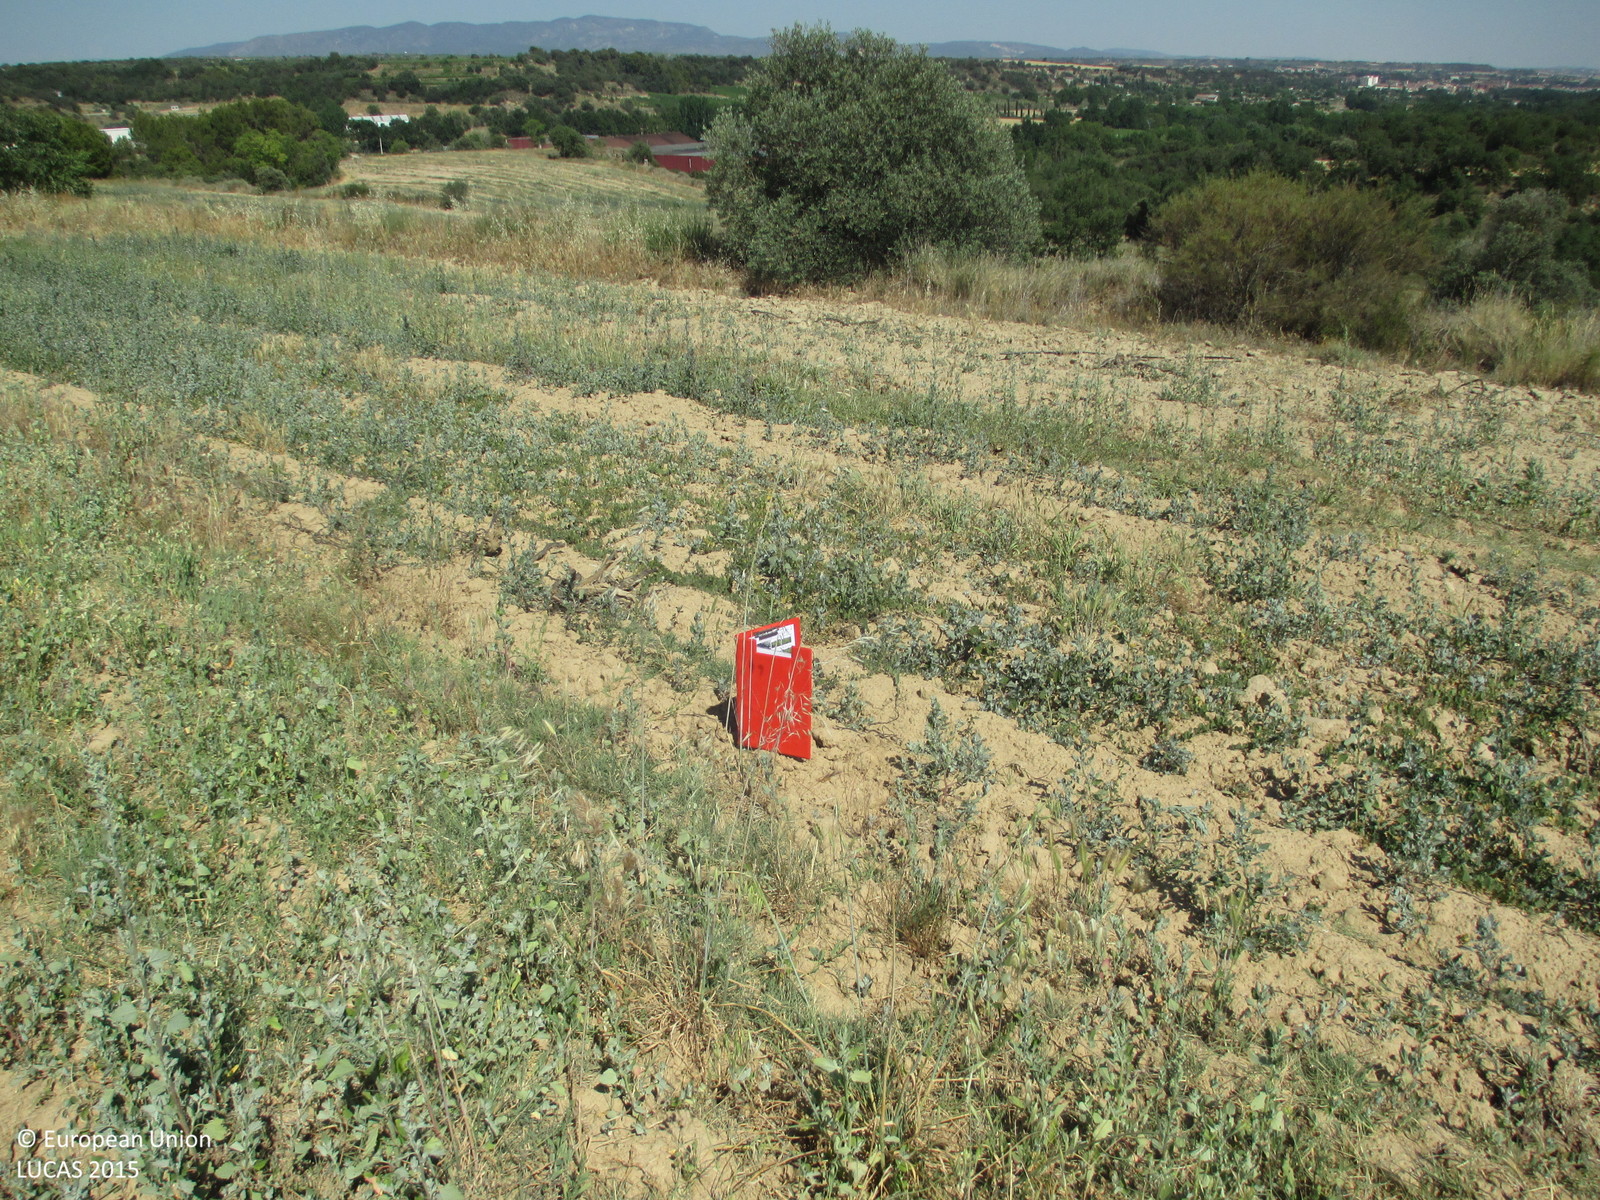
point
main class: Grassland
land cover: Spontaneously vegetated surfaces
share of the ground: 50 - 75 %
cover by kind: herbaceous plants 70 %, unconsolidated bare surface 30 %
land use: Fallow land
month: June
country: ES
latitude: 42.0573
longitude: 0.0848
